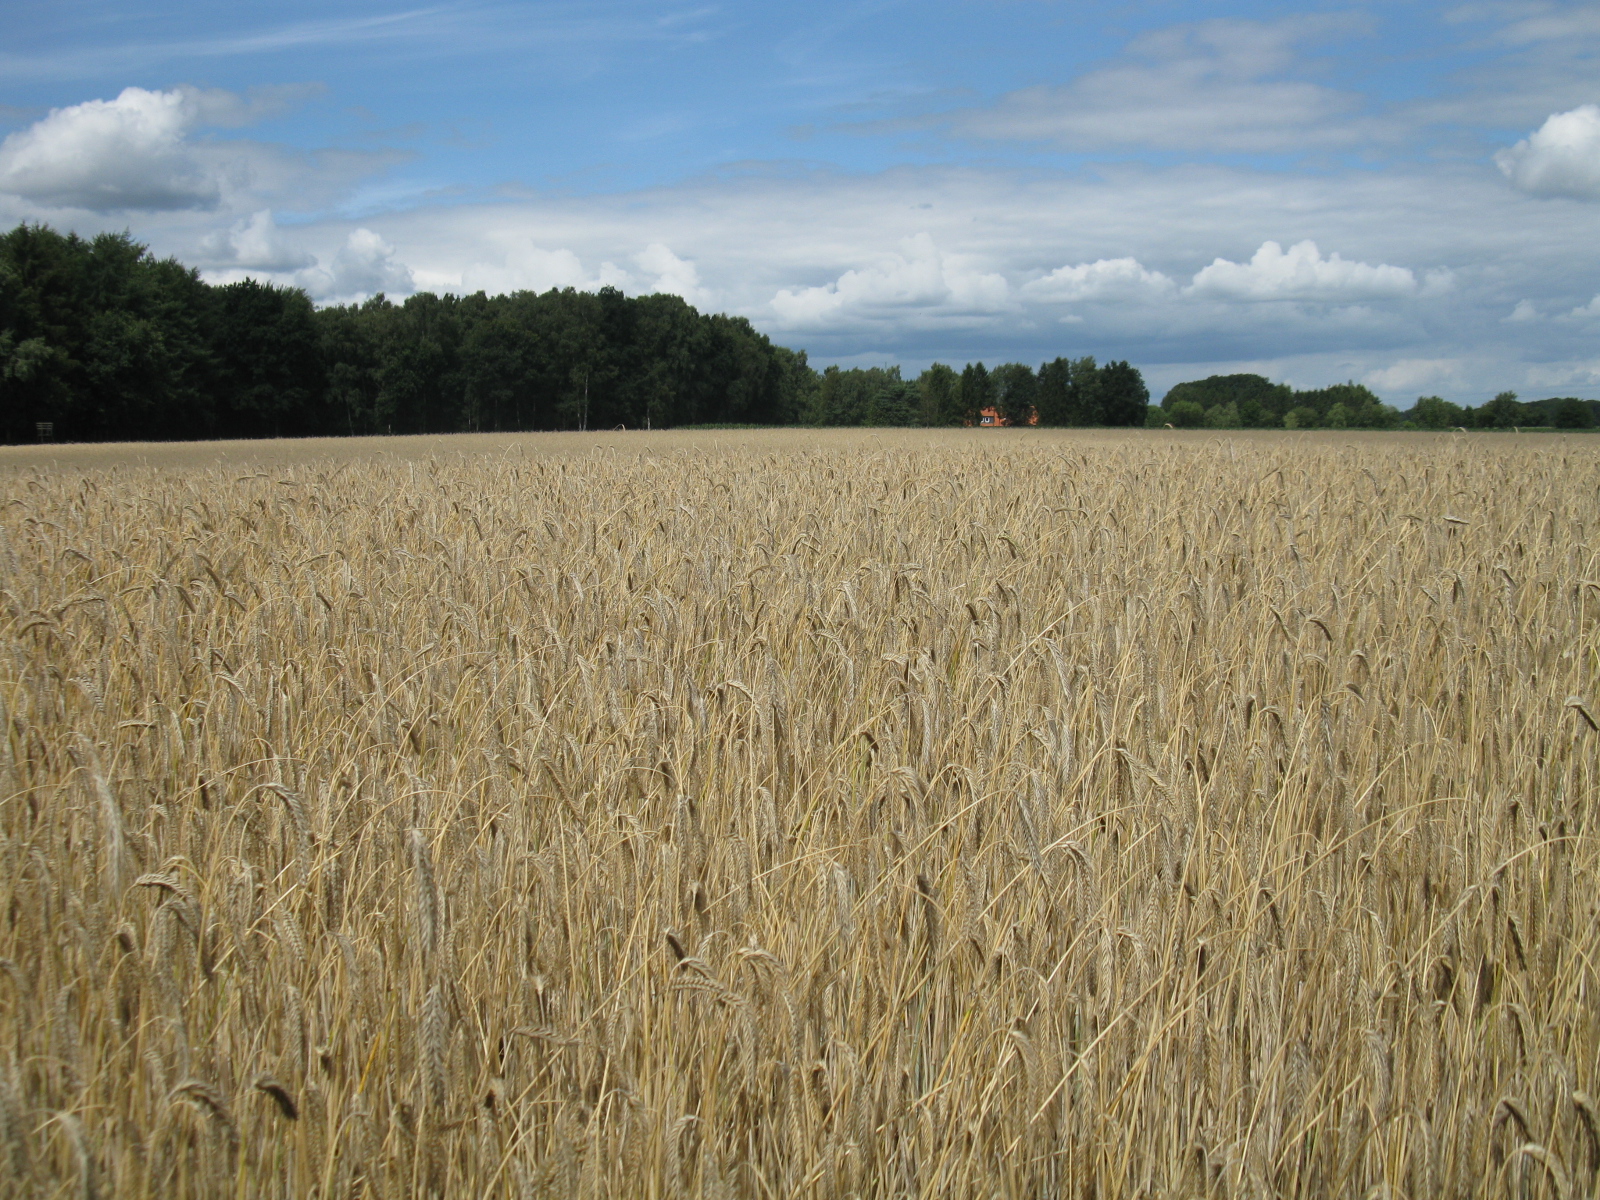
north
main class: Cropland
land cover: Rye
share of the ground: > 75 %
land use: Agriculture (excluding fallow land and kitchen gardens)
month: July
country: DE
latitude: 52.9616
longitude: 8.5267
